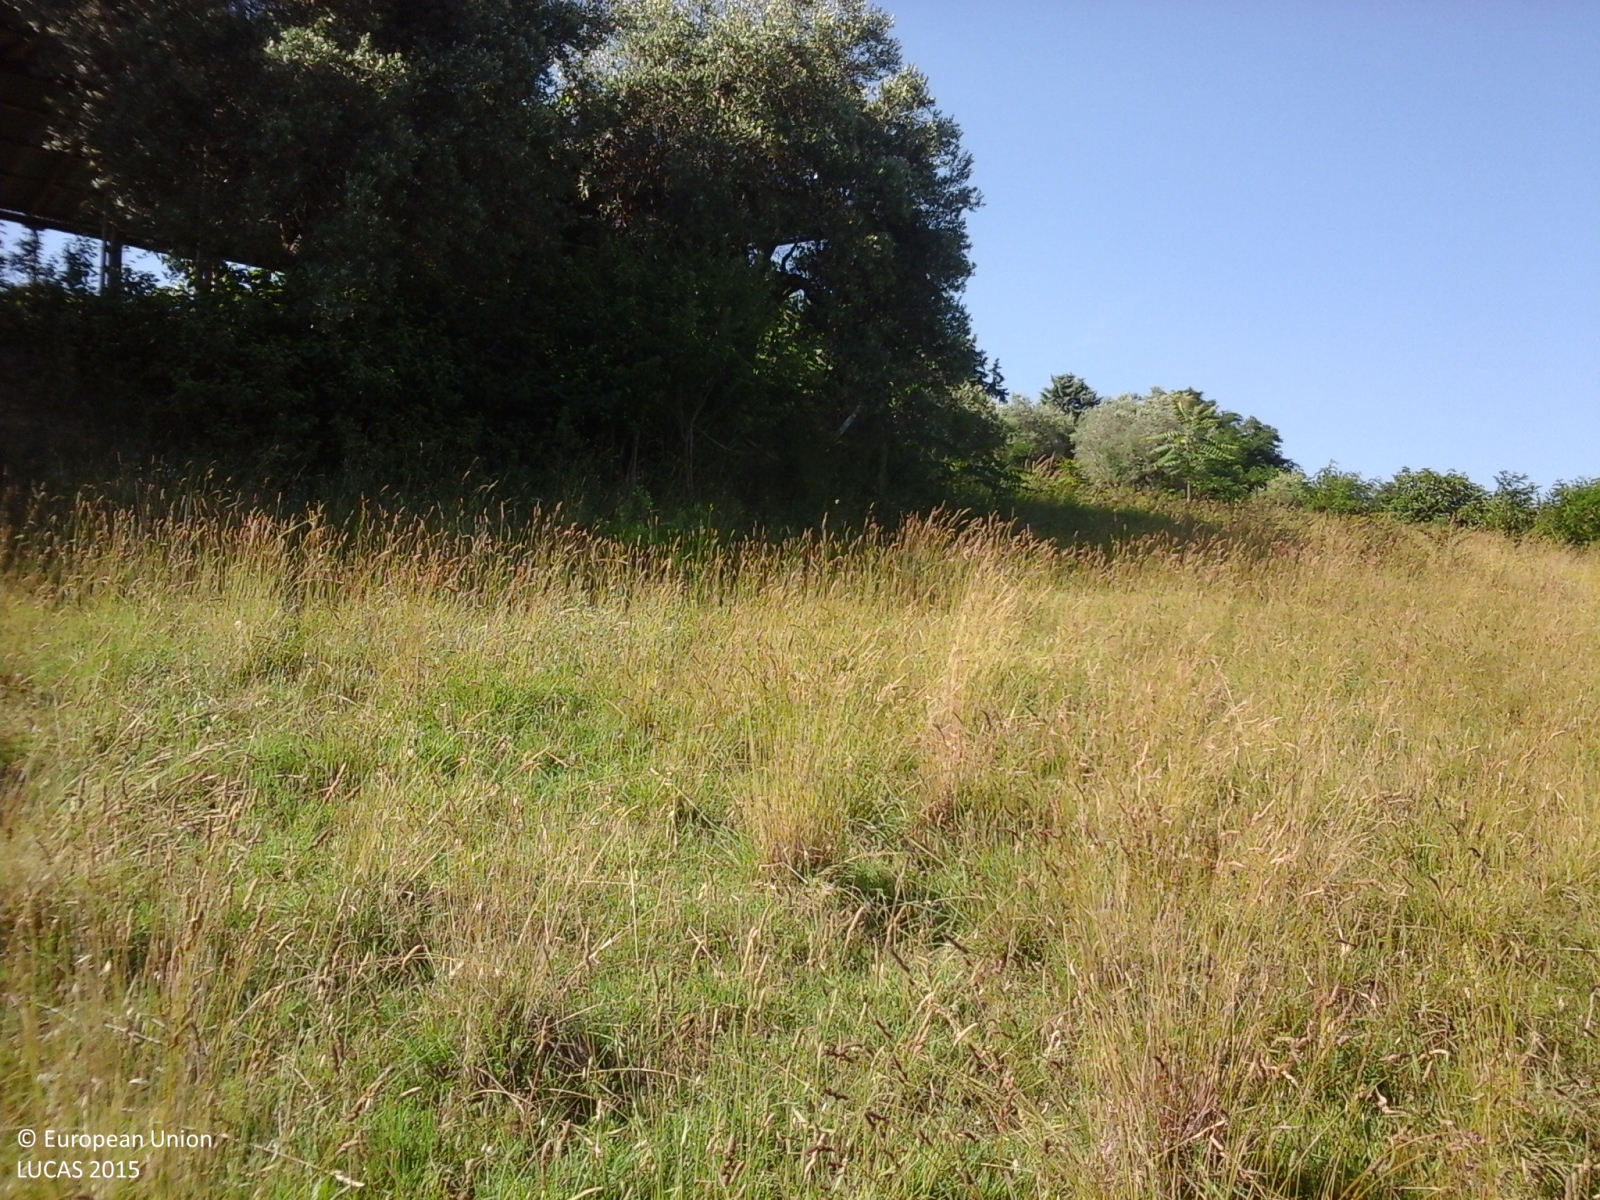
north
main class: Grassland
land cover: Grassland without tree/shrub cover
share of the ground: > 75 %
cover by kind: herbaceous plants 100 %
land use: Agriculture (excluding fallow land and kitchen gardens)
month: June
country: IT
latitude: 42.9082
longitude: 13.7989
